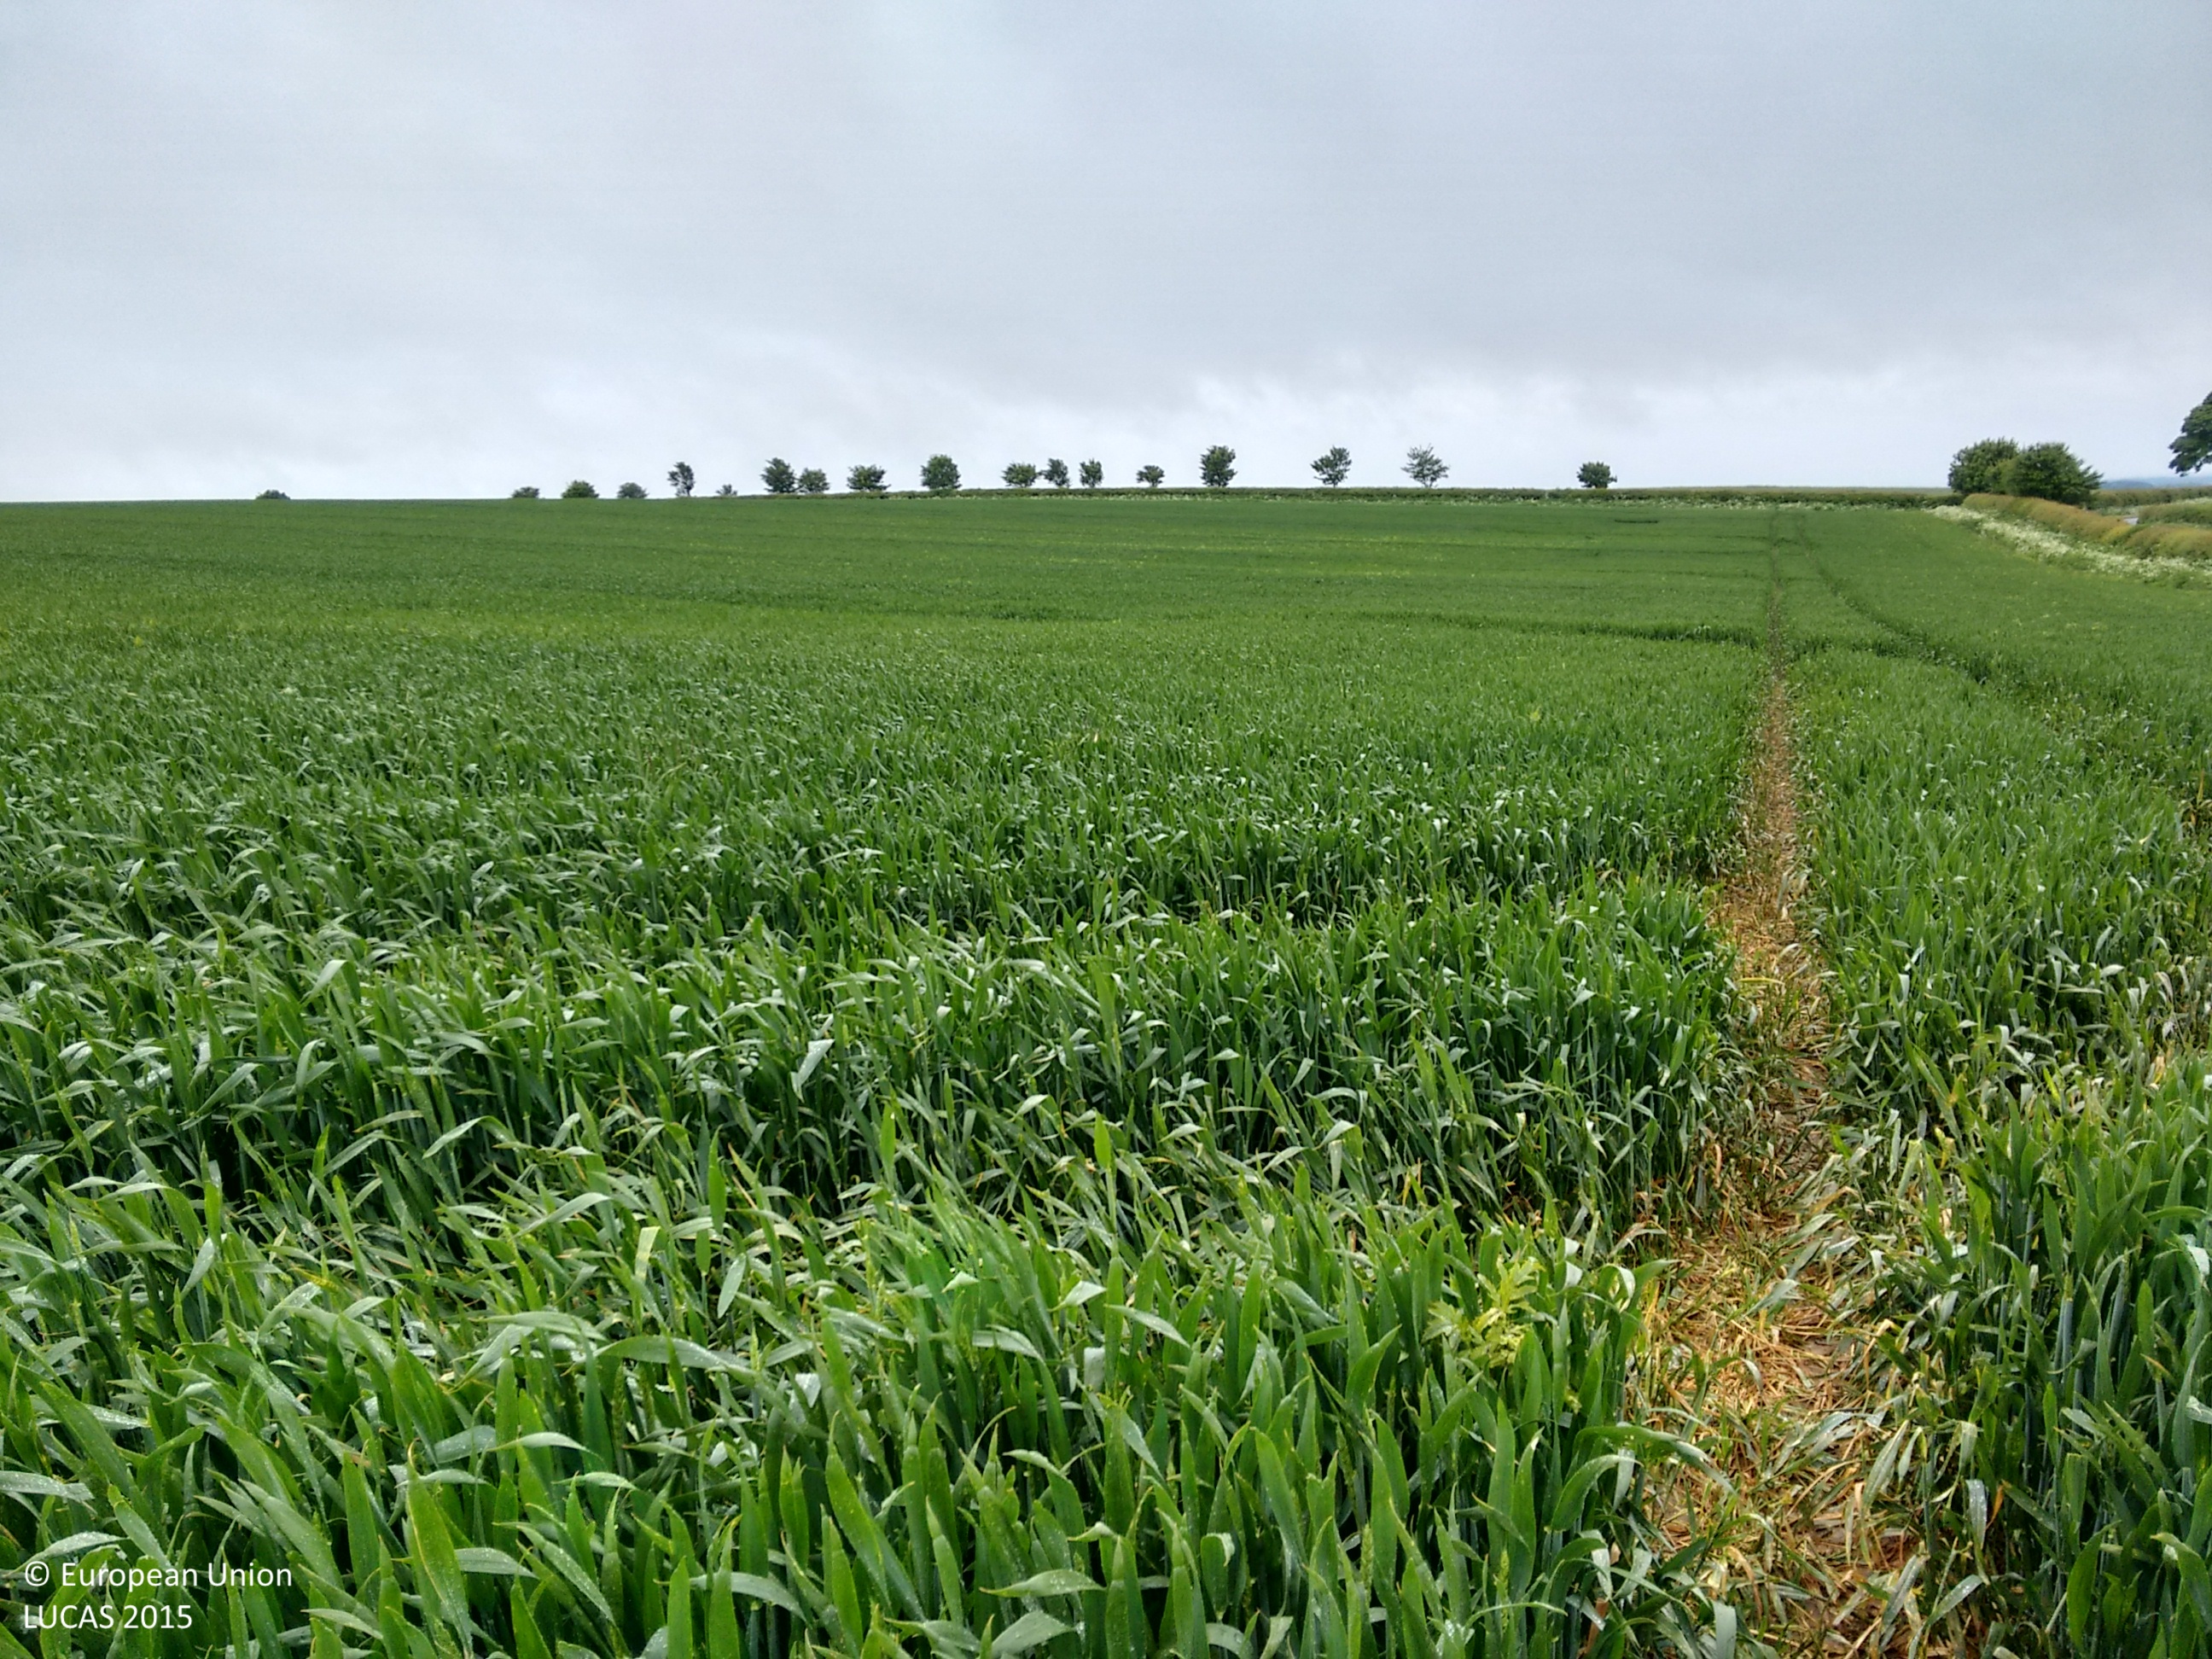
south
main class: Cropland
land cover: Common wheat
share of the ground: > 75 %
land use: Agriculture (excluding fallow land and kitchen gardens)
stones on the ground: 10 - 25 %
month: June
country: GB
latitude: 53.2183
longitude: -0.0517
